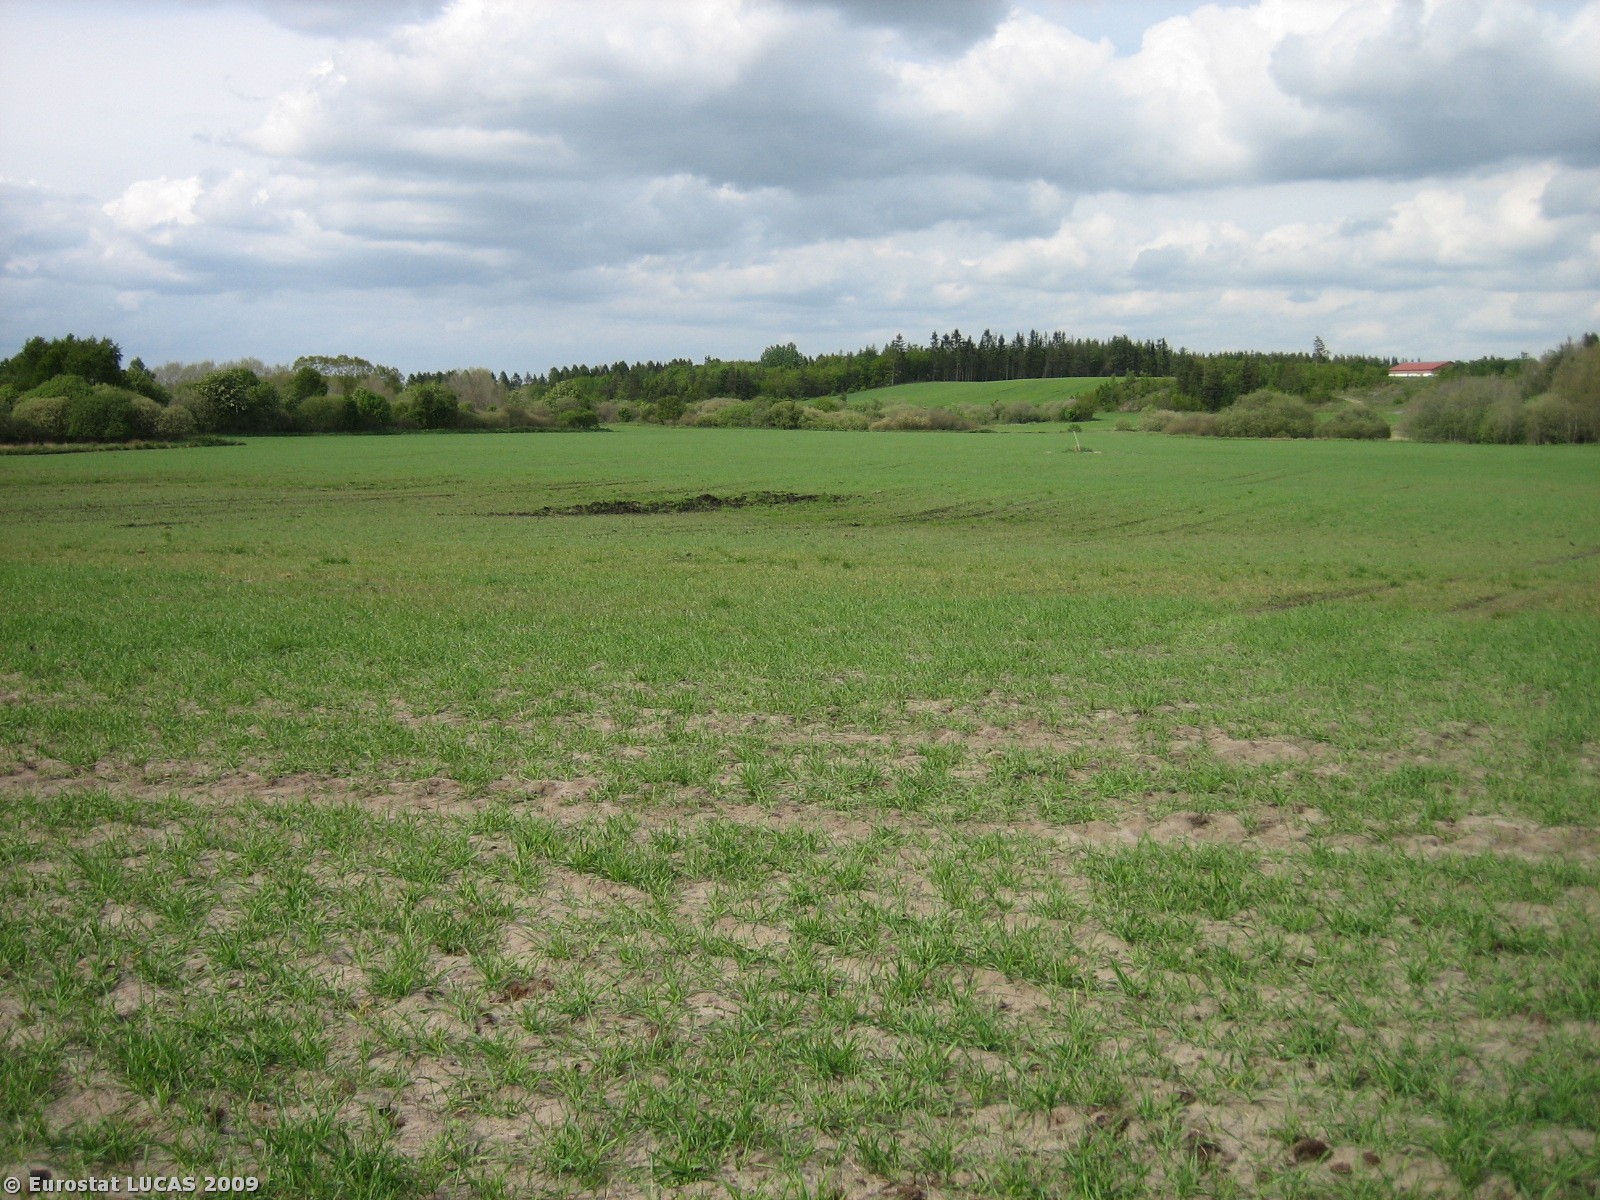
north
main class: Cropland
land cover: Barley
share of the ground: 25 - 50 %
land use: Agriculture (excluding fallow land and kitchen gardens)
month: May
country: DK
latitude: 56.2213
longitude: 9.2107
